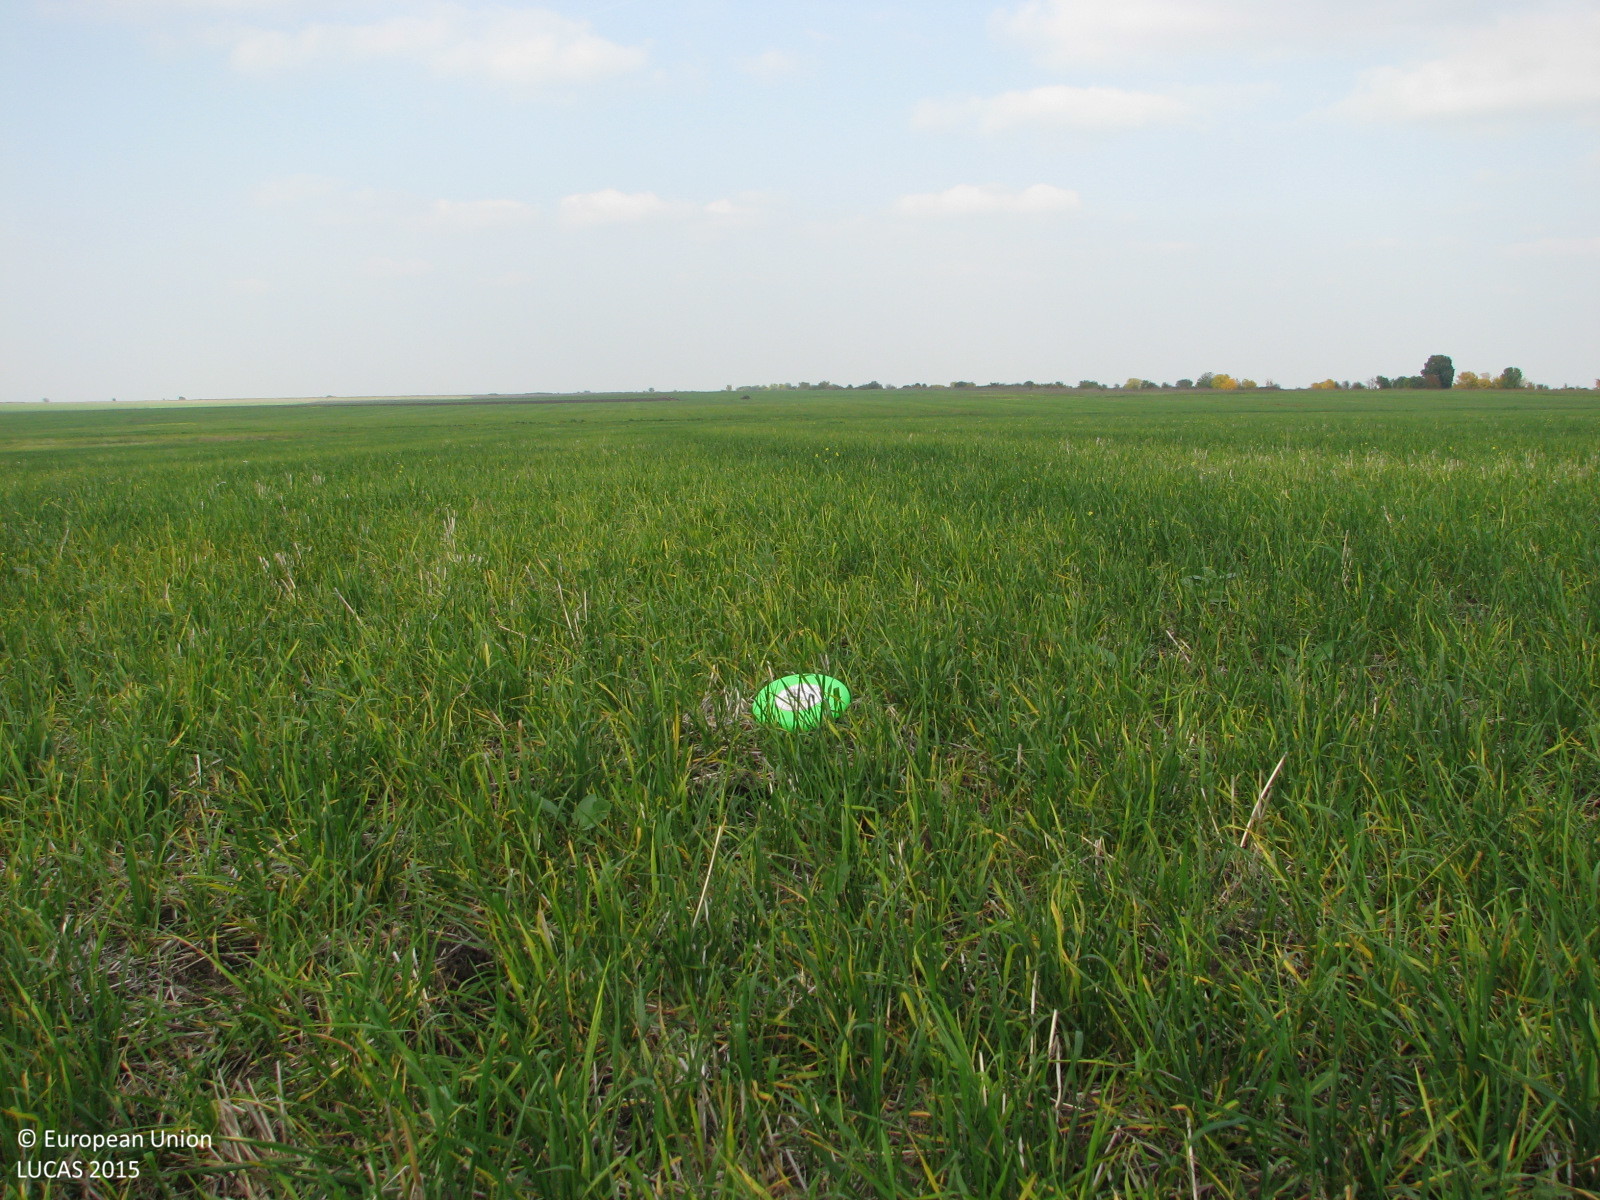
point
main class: Cropland
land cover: Common wheat
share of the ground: > 75 %
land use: Agriculture (excluding fallow land and kitchen gardens)
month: October
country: BG
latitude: 42.3403
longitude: 26.4880
